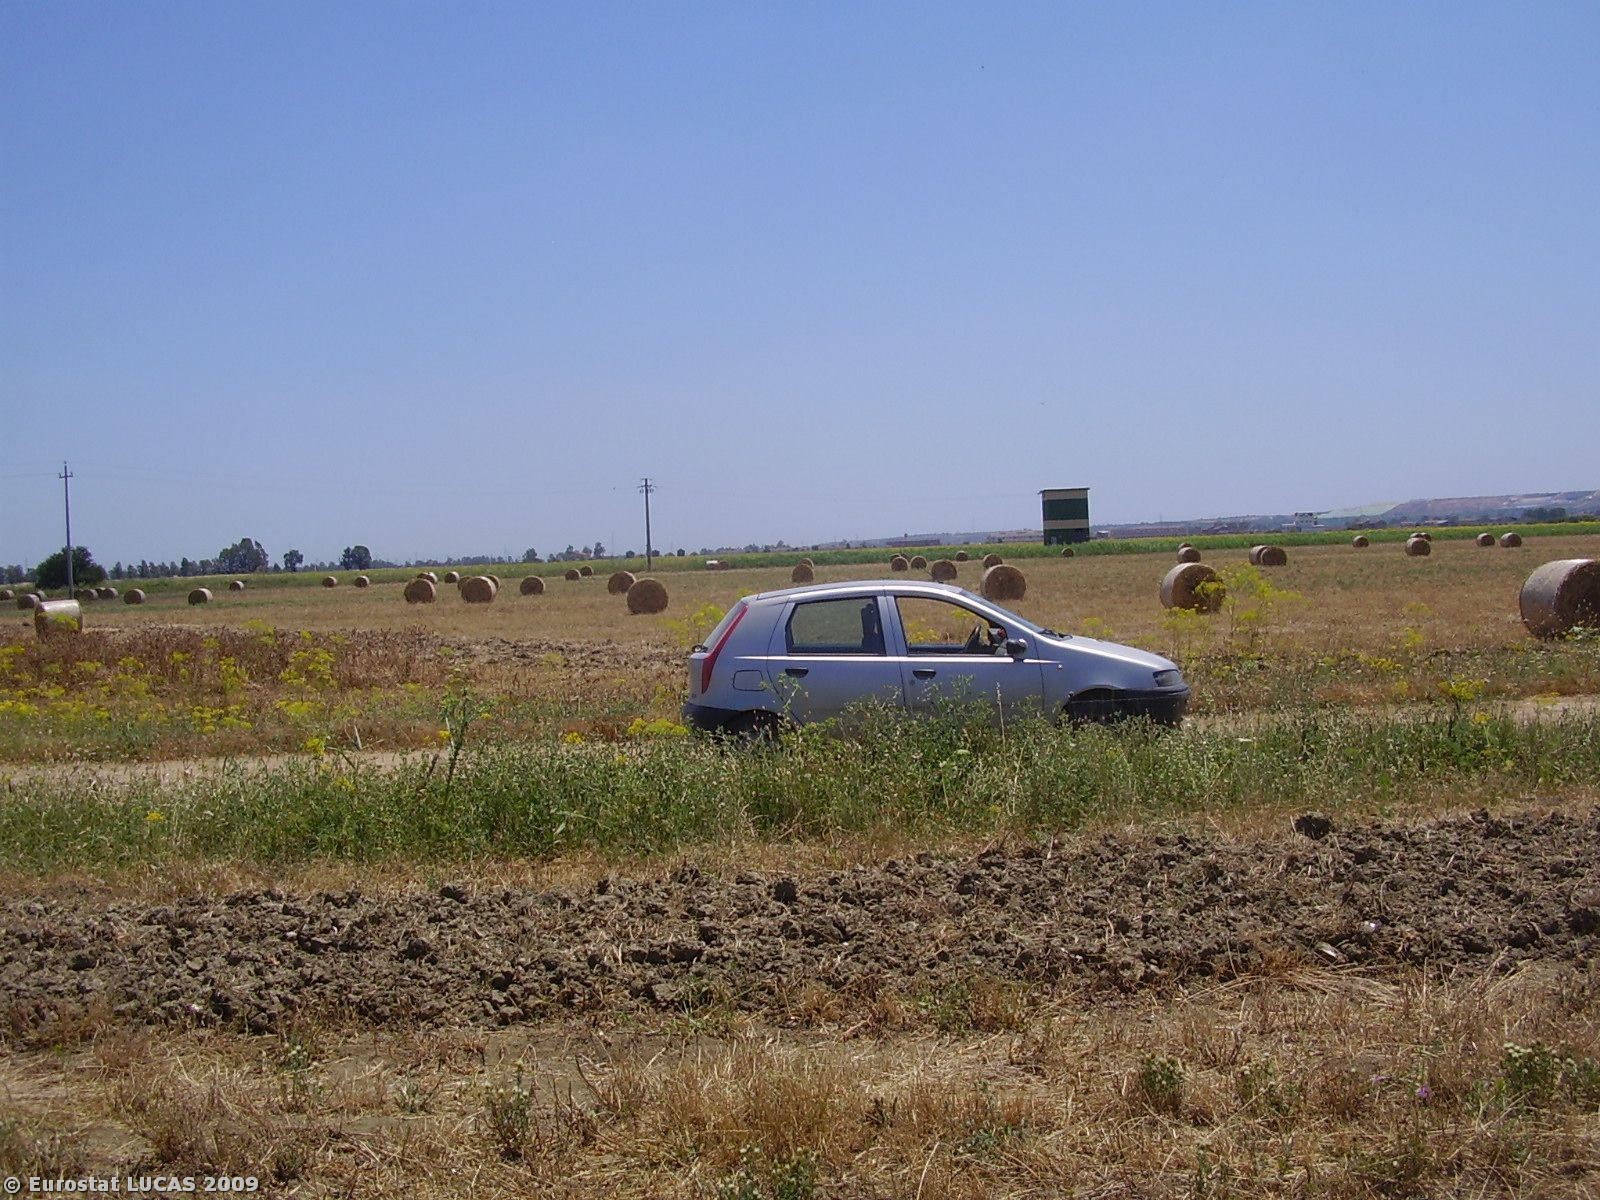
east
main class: Cropland
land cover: Other cereals
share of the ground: > 75 %
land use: Agriculture (excluding fallow land and kitchen gardens)
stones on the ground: < 10 %
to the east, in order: Other cereals; Ditches and canals; Tracks; Ditches and canals; Spontaneously vegetated surfaces; Electric lines; Spontaneously vegetated surfaces
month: June
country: IT
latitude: 37.3994
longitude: 14.9679
